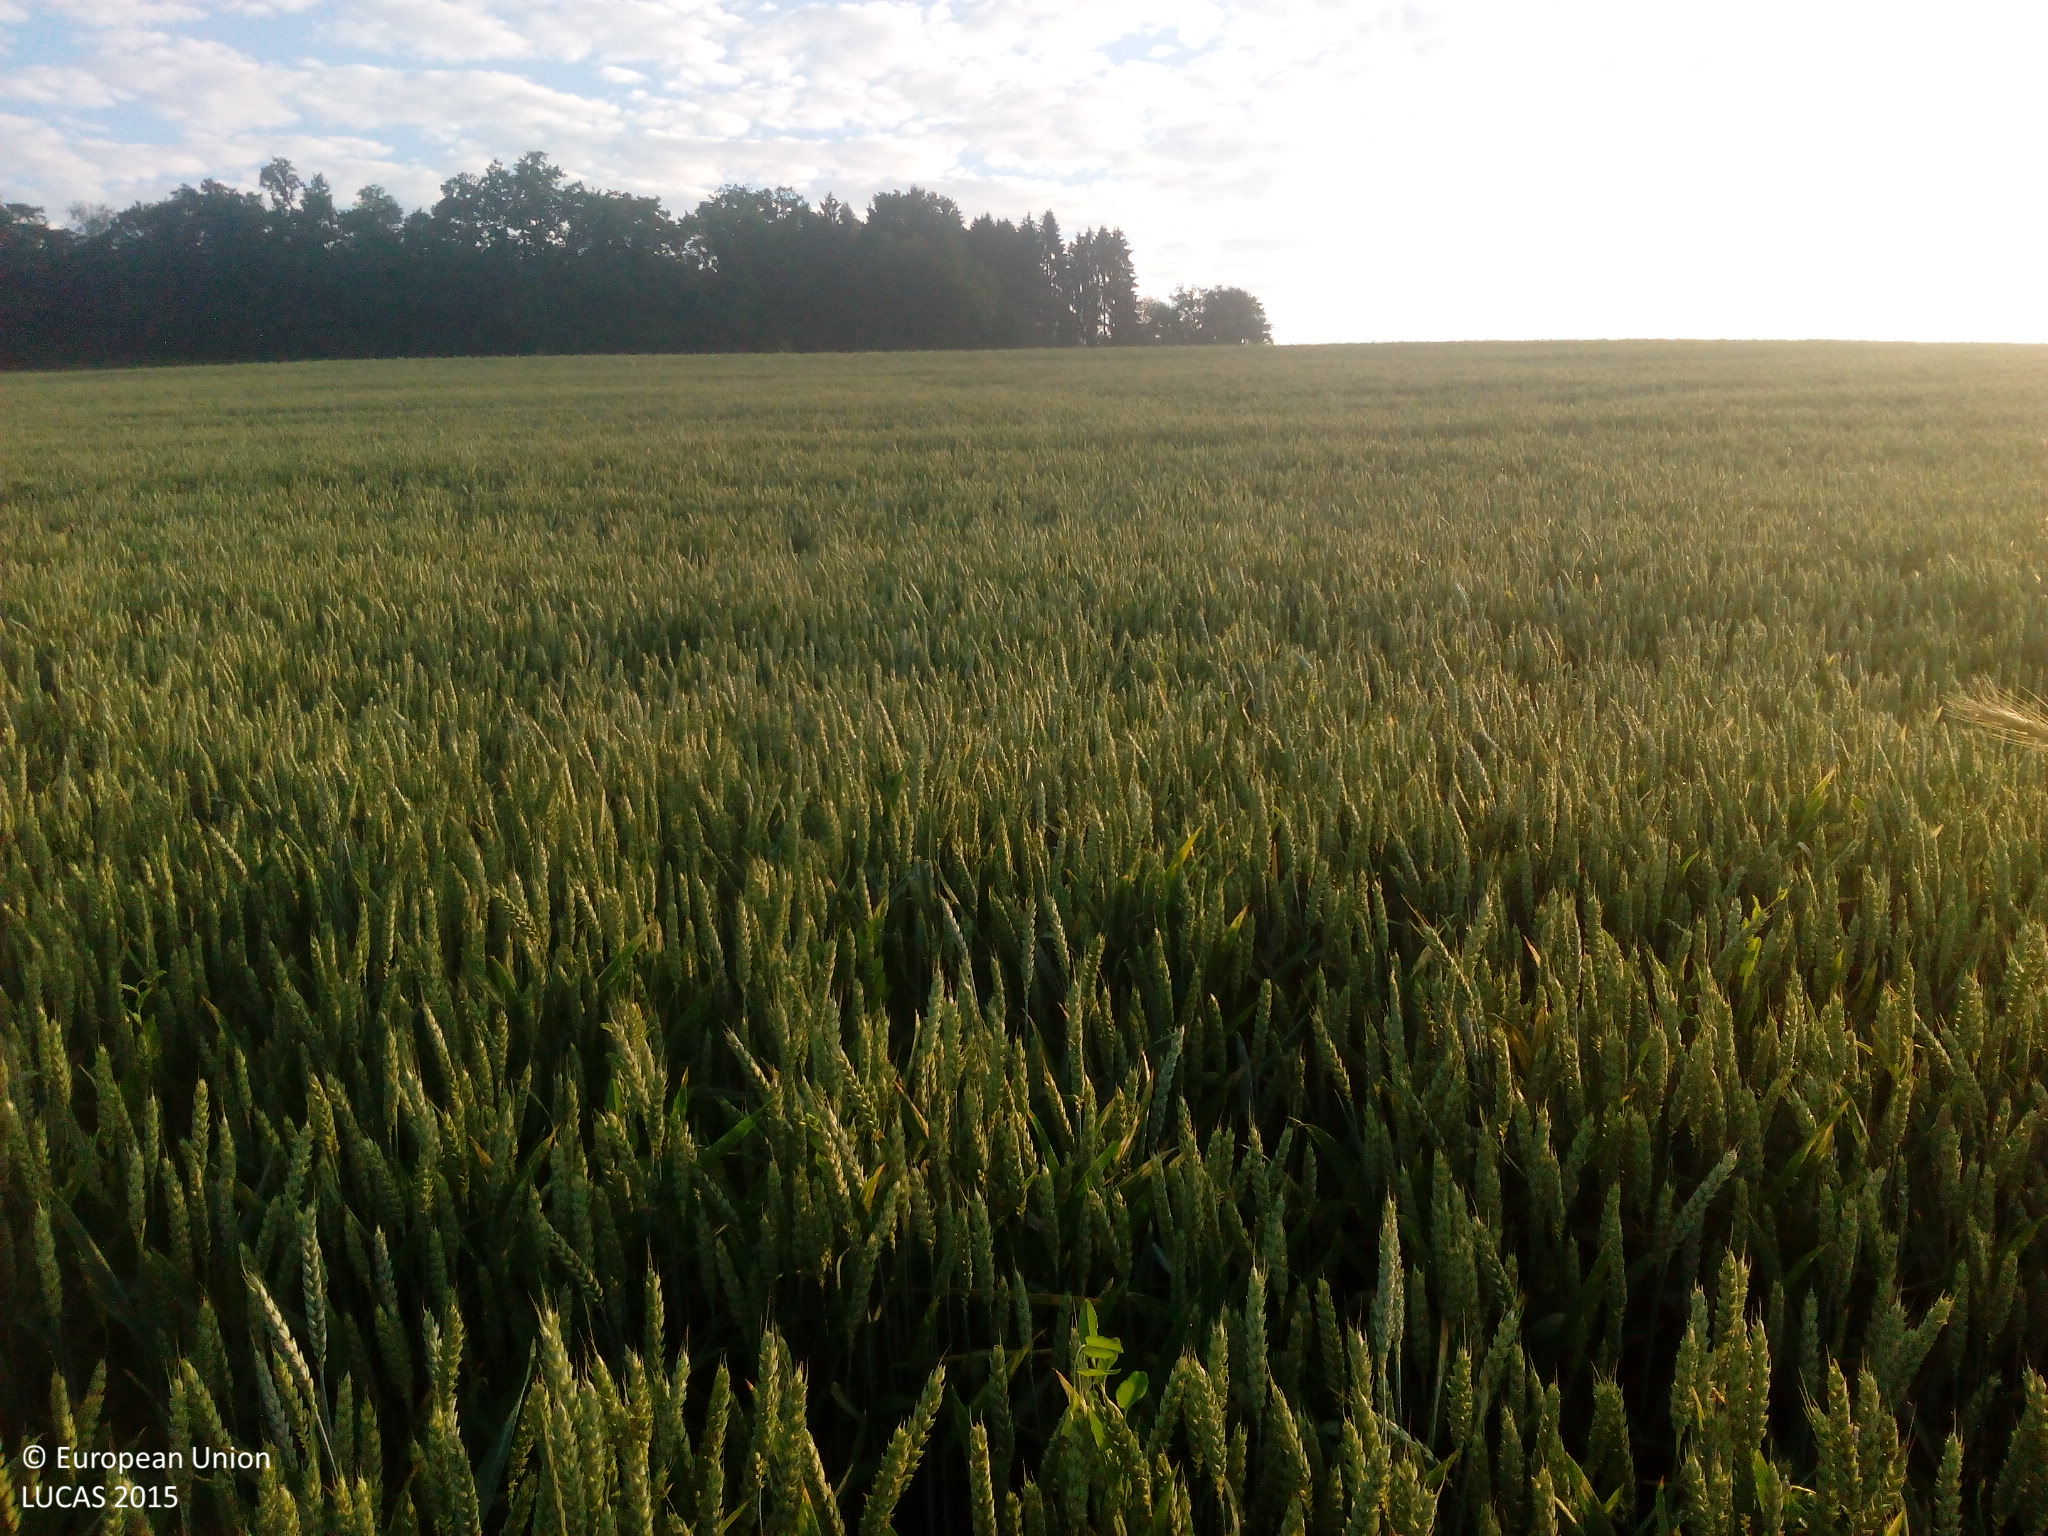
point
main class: Cropland
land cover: Common wheat
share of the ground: > 75 %
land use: Agriculture (excluding fallow land and kitchen gardens)
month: July
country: DE
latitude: 48.8678
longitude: 10.8857
